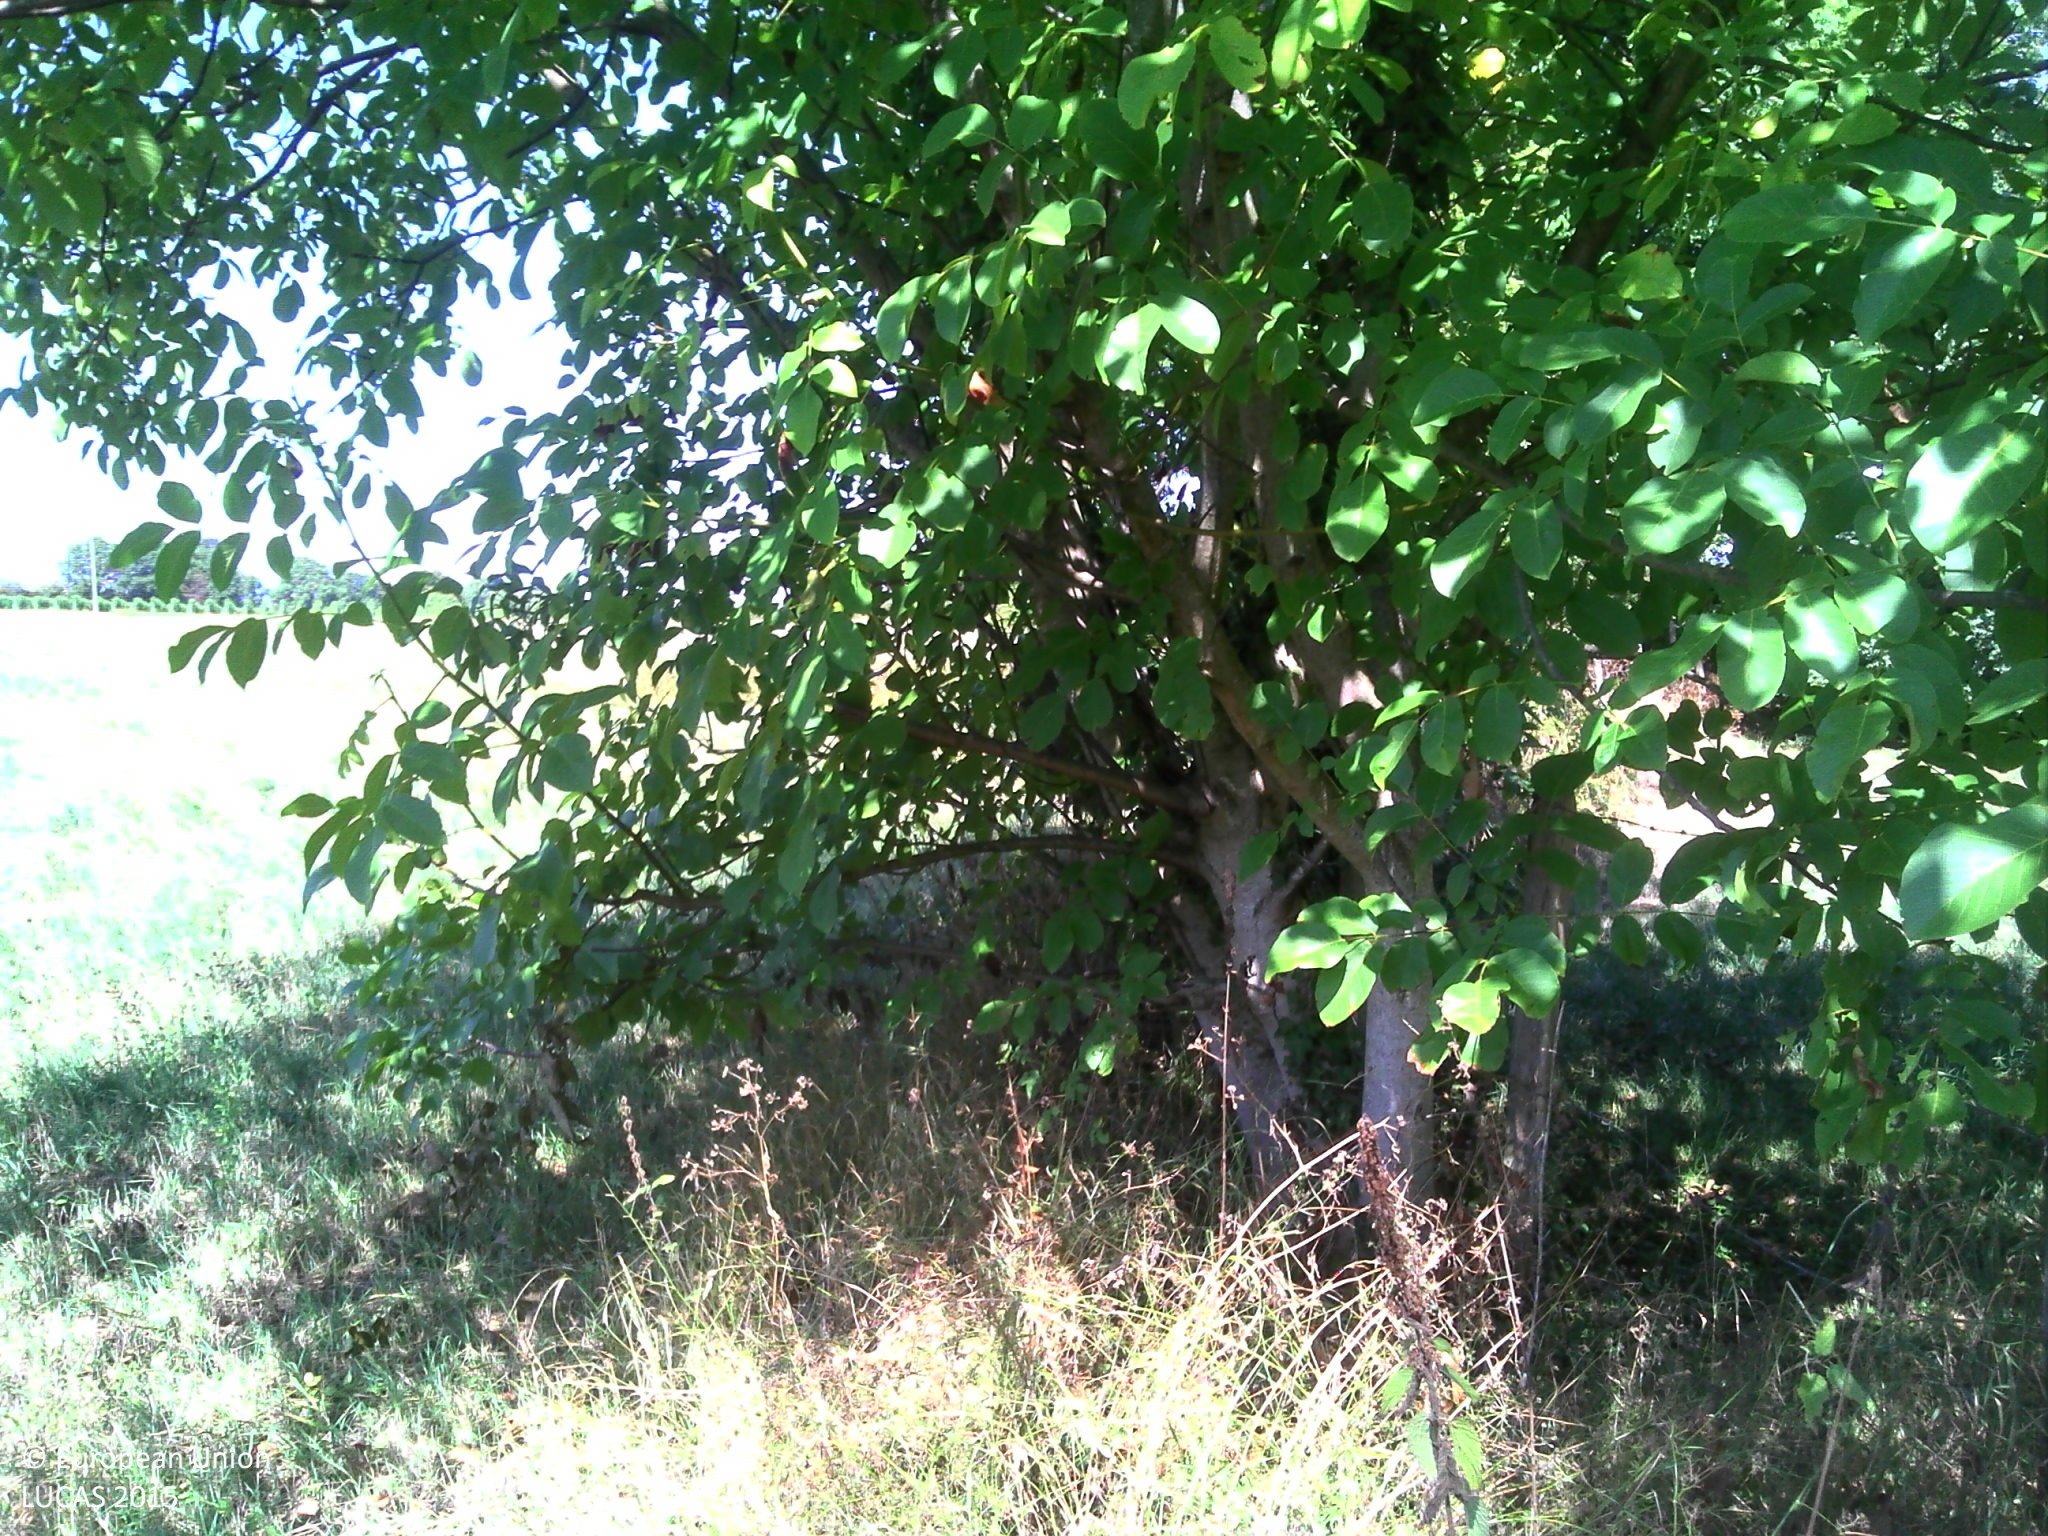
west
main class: Cropland
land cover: Apple fruit
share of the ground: > 75 %
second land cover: Grassland without tree/shrub cover
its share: > 75 %
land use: Kitchen garden
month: August
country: FR
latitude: 46.3327
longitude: 4.7930
